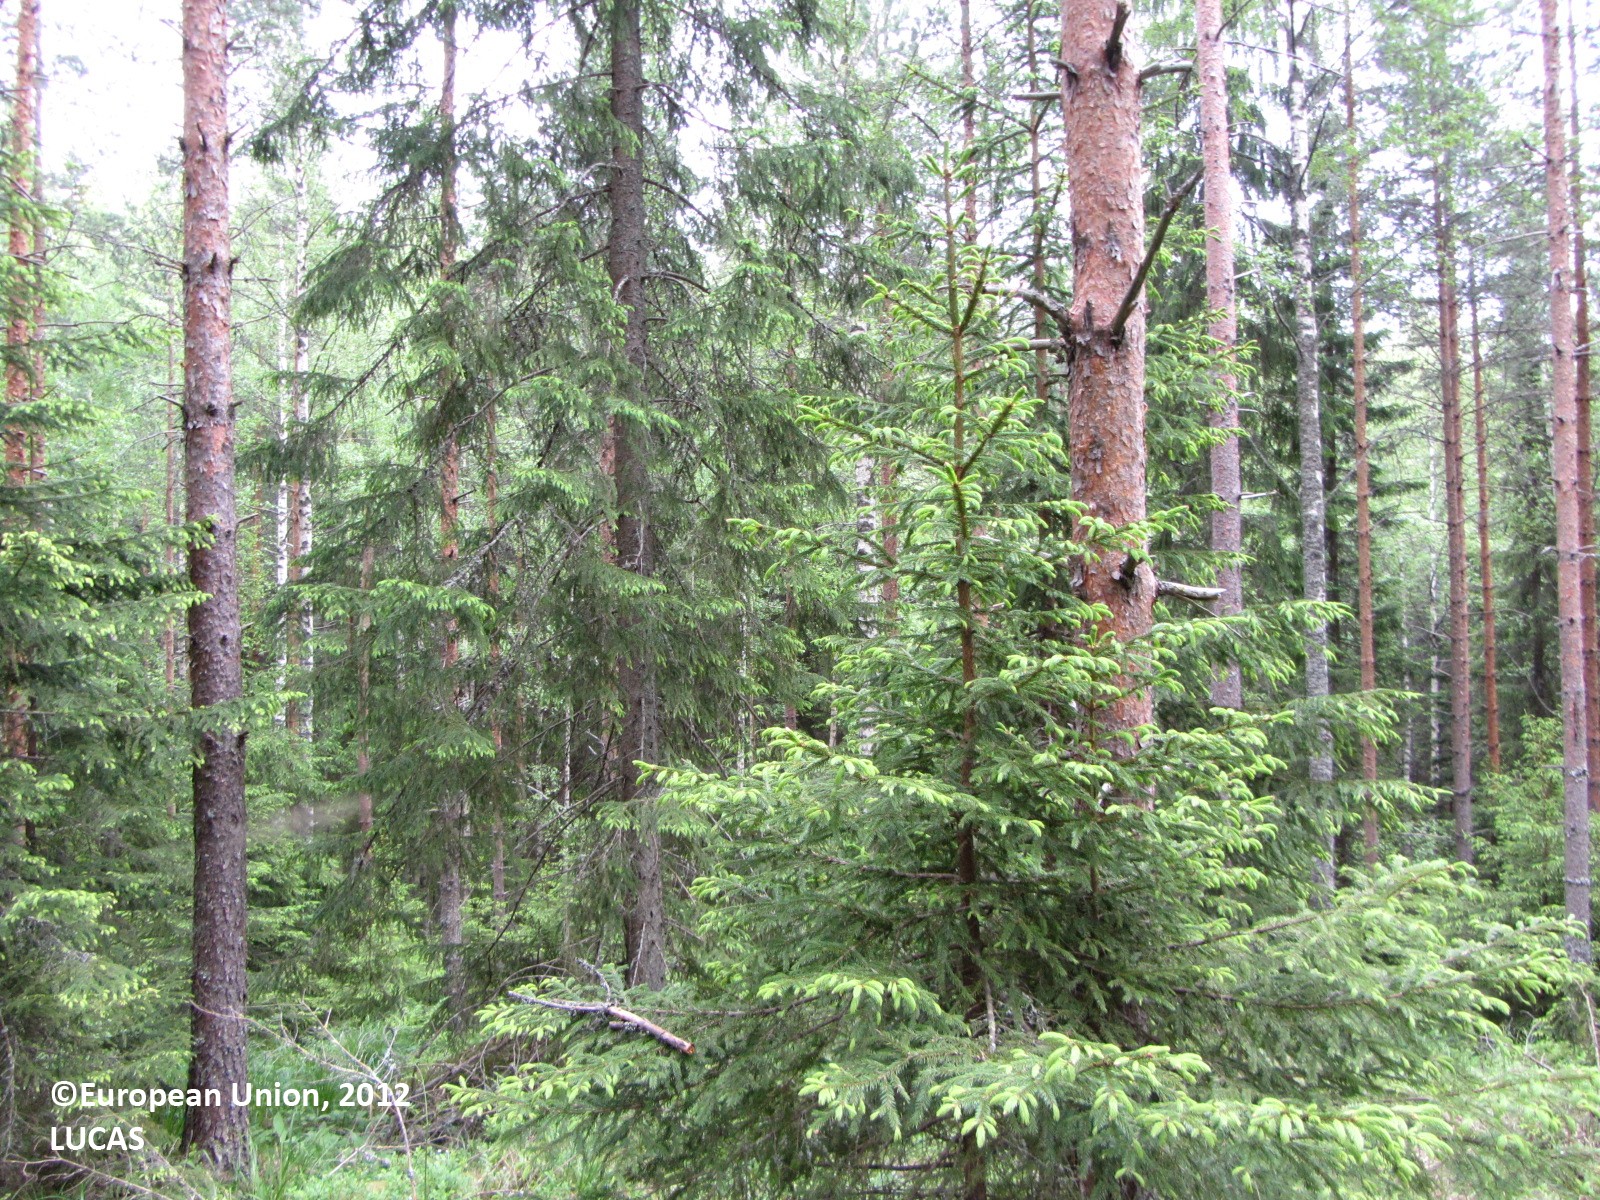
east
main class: Woodland
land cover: Other coniferous woodland
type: hemiboreal forest and nemoral coniferous forest and mixed broadleaved-coniferous forest
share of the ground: > 75 %
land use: Forestry
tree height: > 5 m
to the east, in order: Other coniferous woodland; Grassland with sparse tree/shrub cover; Other mixed woodland; Spruce dominated coniferous woodland; Grassland with sparse tree/shrub cover; Spruce dominated coniferous woodland; Shrubland with sparse tree cover; Spruce dominated coniferous woodland
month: June
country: FI
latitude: 61.7394
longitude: 25.0460
